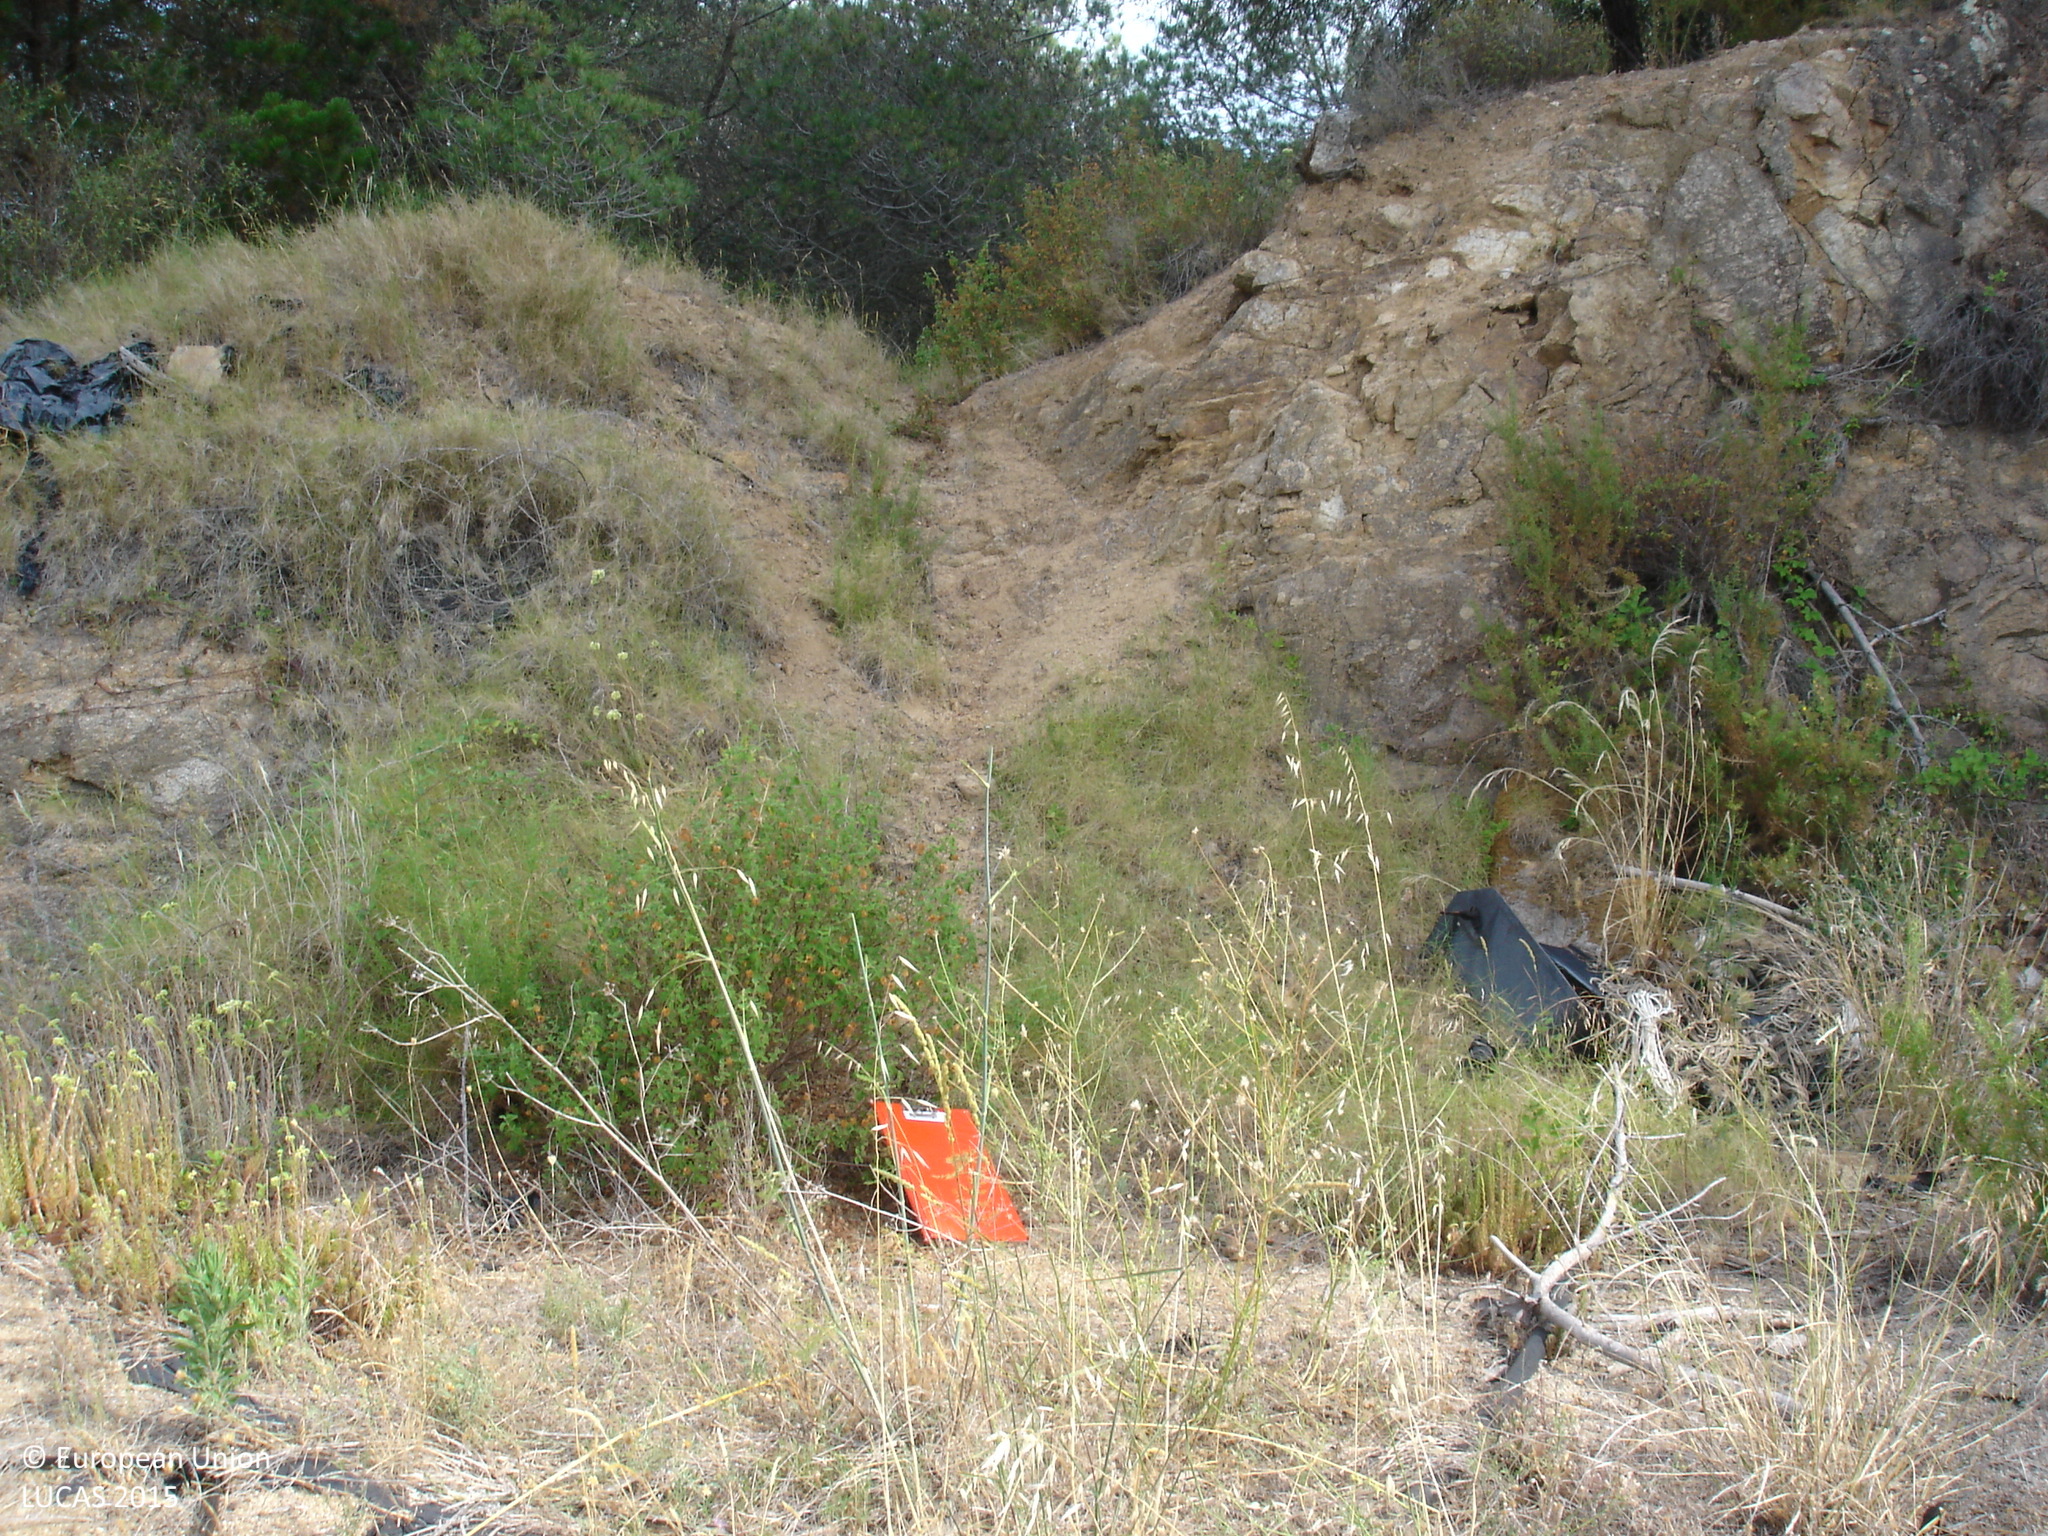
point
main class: Woodland
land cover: Pine dominated mixed woodland
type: coniferous forest of the mediterranean region
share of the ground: 50 - 75 %
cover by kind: coniferous forest trees 45 %, herbaceous plants 25 %, broadleaved forest trees 15 %, consolidated bare surface 10 %, shrubs 5 %
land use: Forestry
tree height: > 5 m
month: June
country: ES
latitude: 41.6206
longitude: 2.5882
